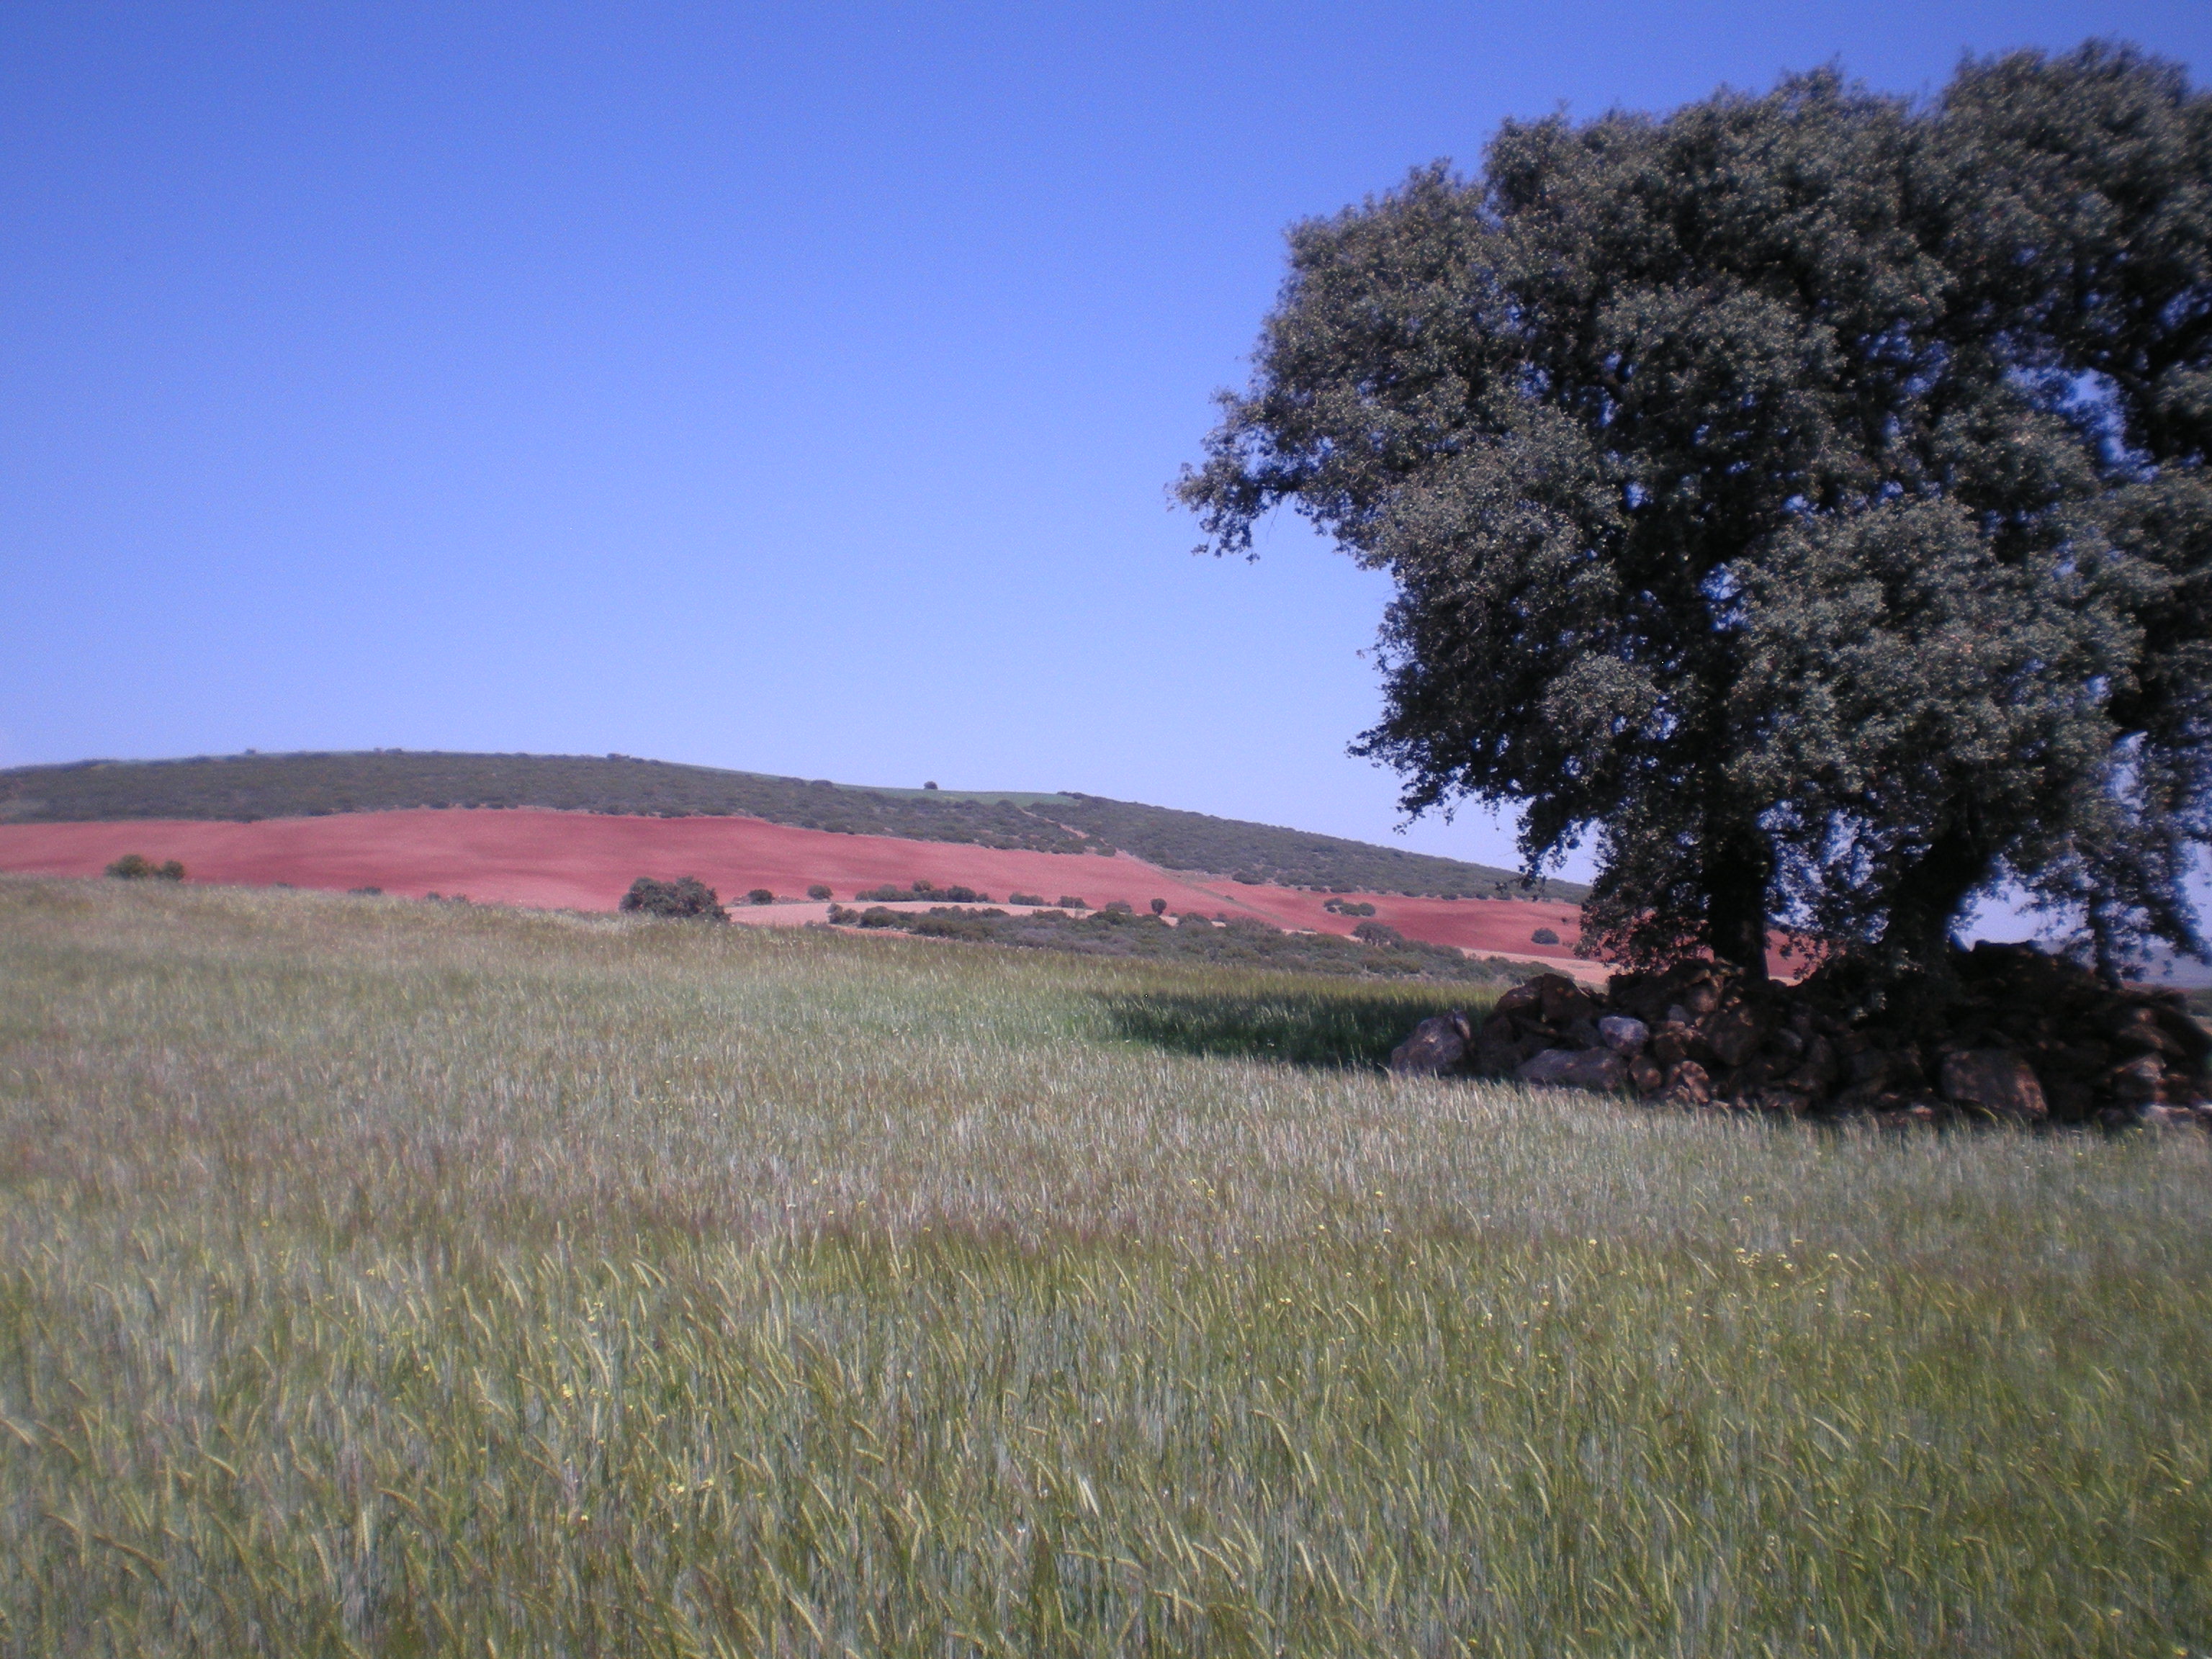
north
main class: Cropland
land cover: Barley
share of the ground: > 75 %
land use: Agriculture (excluding fallow land and kitchen gardens)
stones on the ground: 10 - 25 %
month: April
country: ES
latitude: 38.5575
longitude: -3.5162
